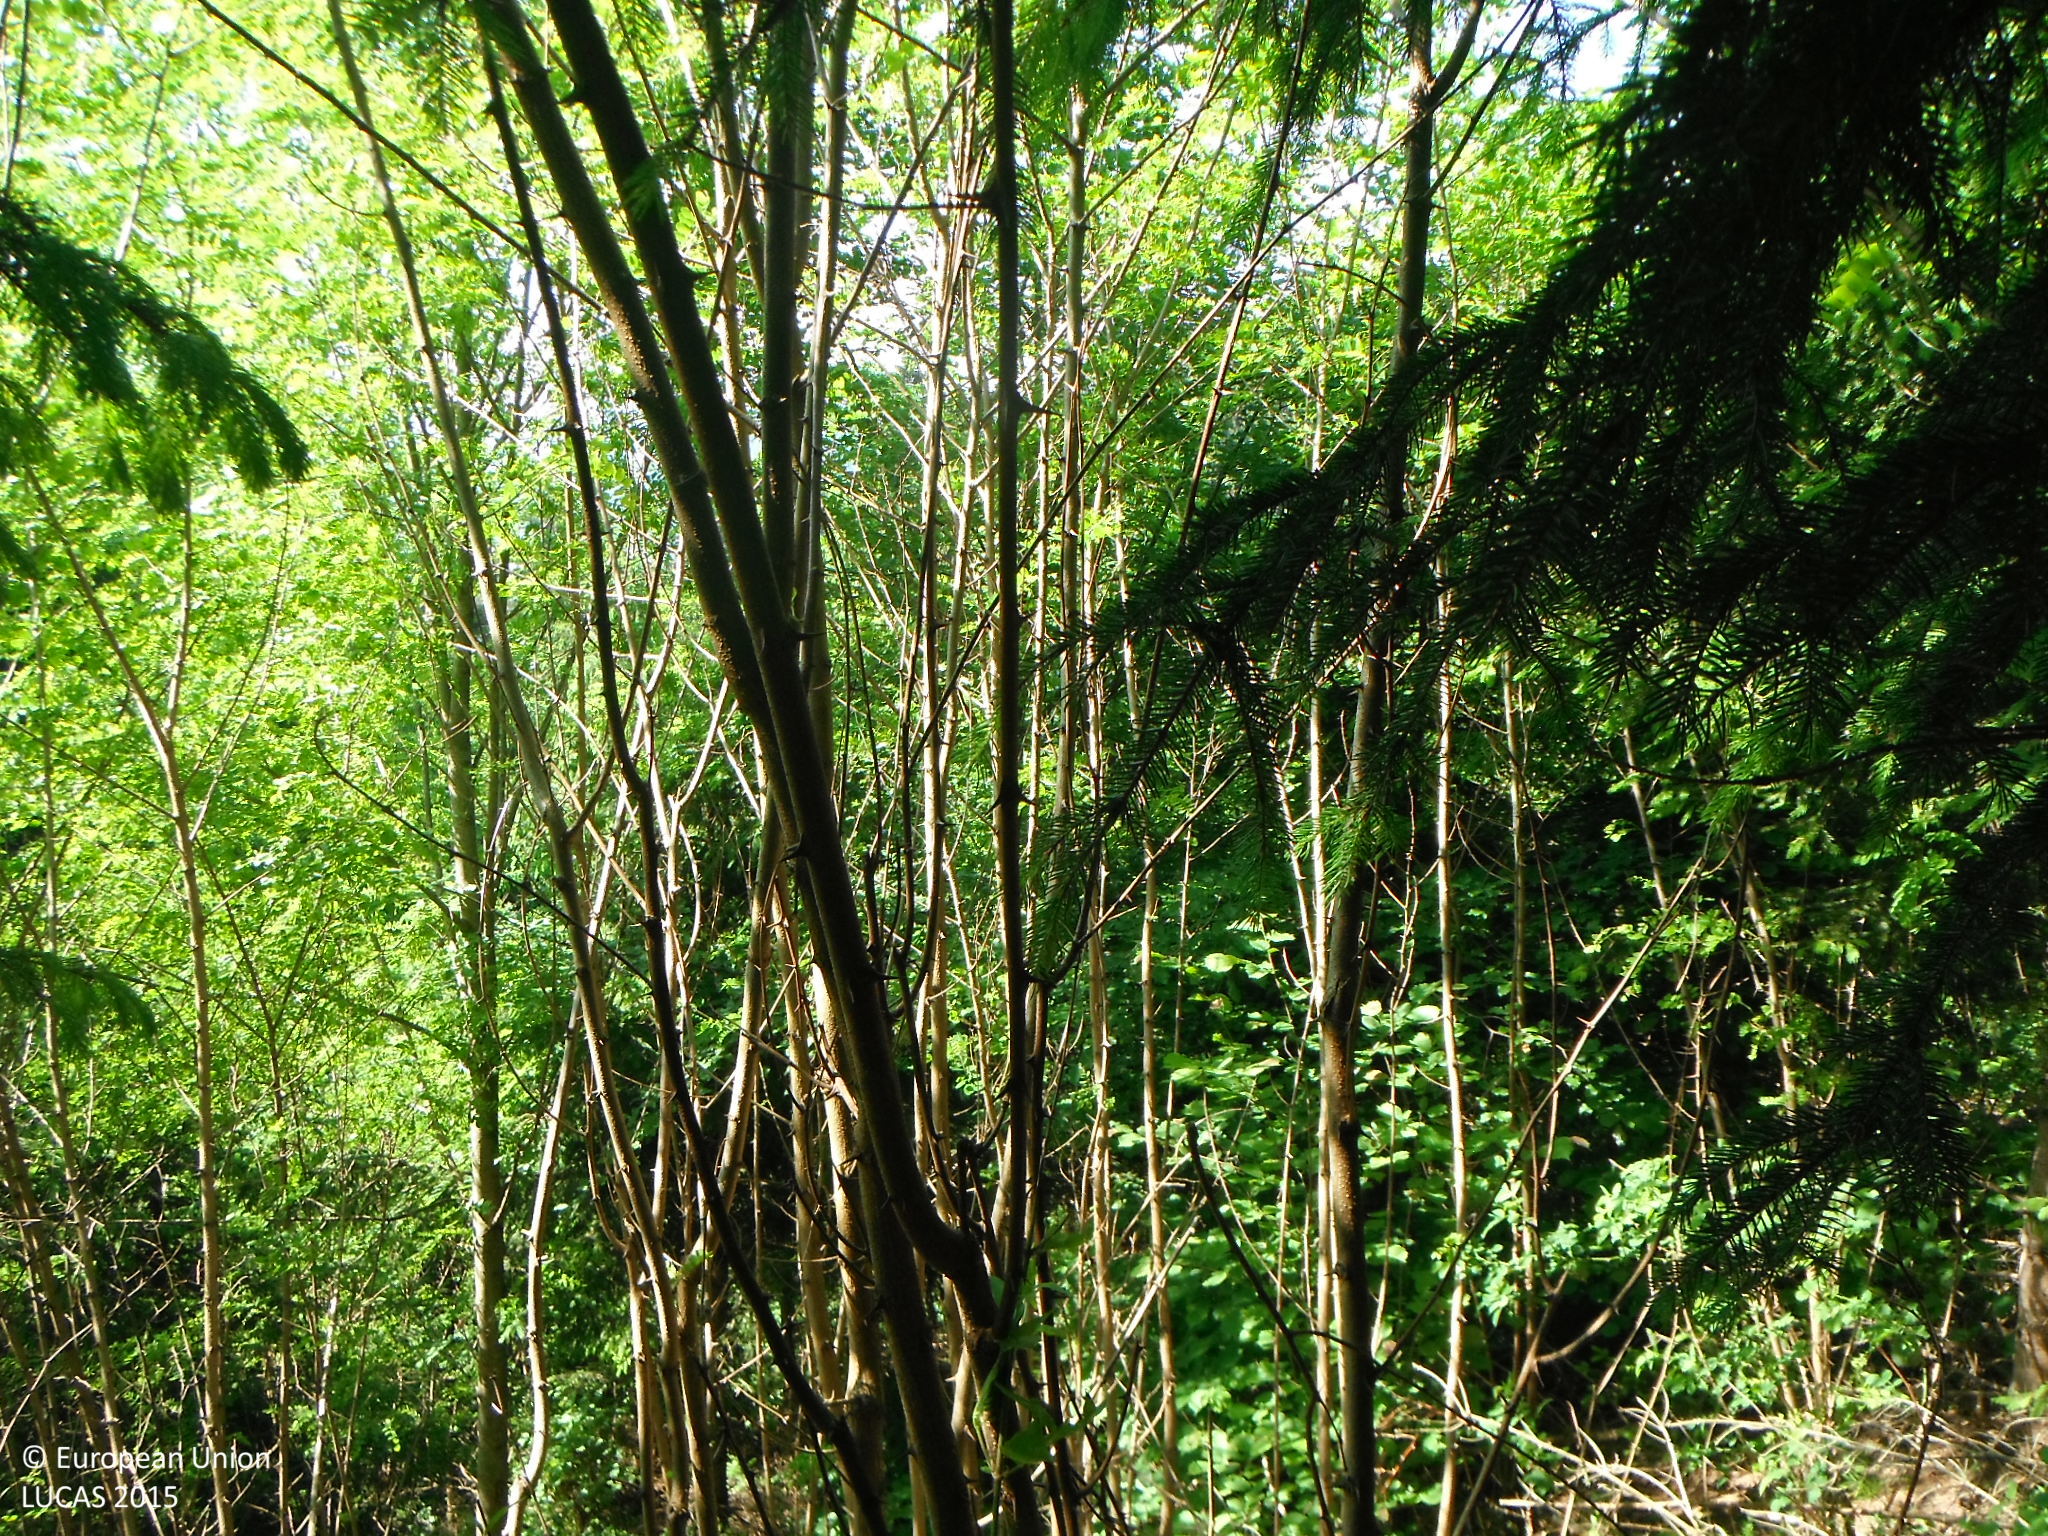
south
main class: Woodland
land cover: Spruce dominated mixed woodland
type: hemiboreal forest and nemoral coniferous forest and mixed broadleaved-coniferous forest
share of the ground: > 75 %
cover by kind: coniferous forest trees 75 %, broadleaved forest trees 25 %
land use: Forestry
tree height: < 5 m
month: June
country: SK
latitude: 48.8205
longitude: 19.5738
